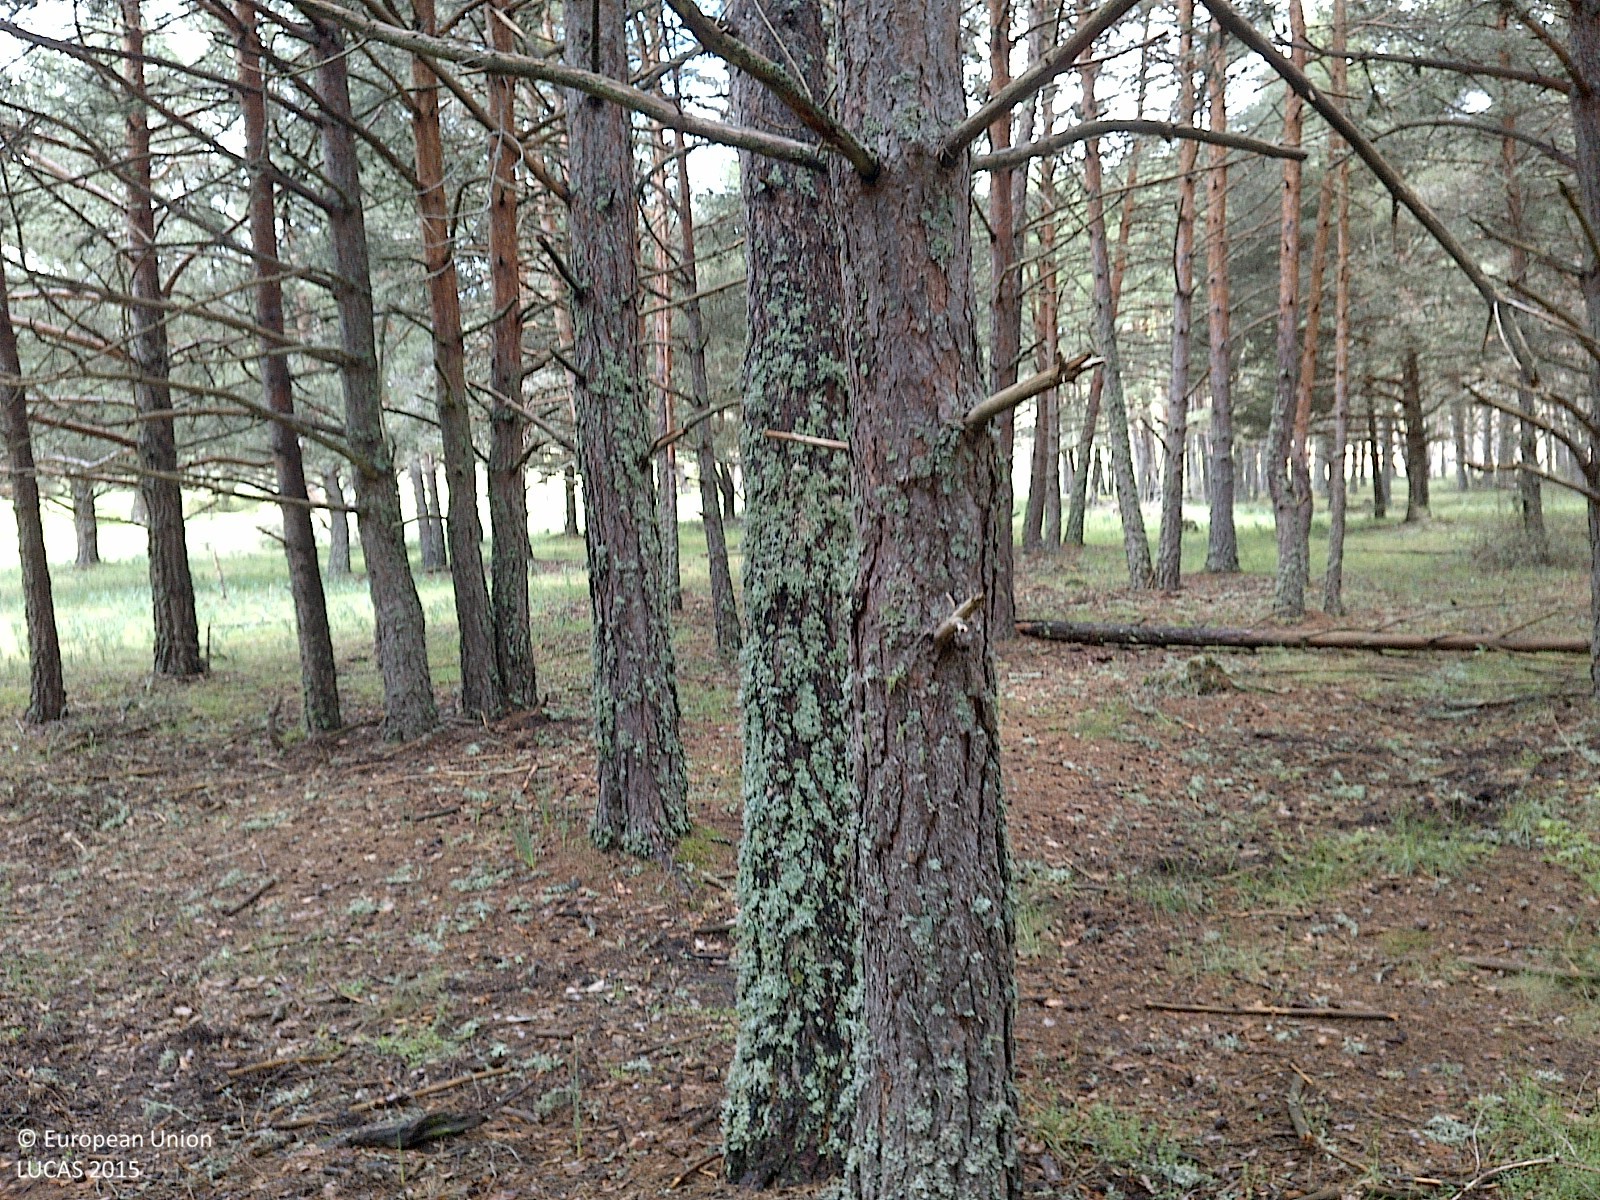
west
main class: Woodland
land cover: Pine dominated coniferous woodland
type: coniferous forest of the mediterranean region
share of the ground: > 75 %
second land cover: Grassland without tree/shrub cover
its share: 50 - 75 %
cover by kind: coniferous forest trees 85 %, herbaceous plants 15 %
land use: Forestry
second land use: Agriculture (excluding fallow land and kitchen gardens)
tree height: > 5 m
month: April
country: ES
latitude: 41.8180
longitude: -2.8156
